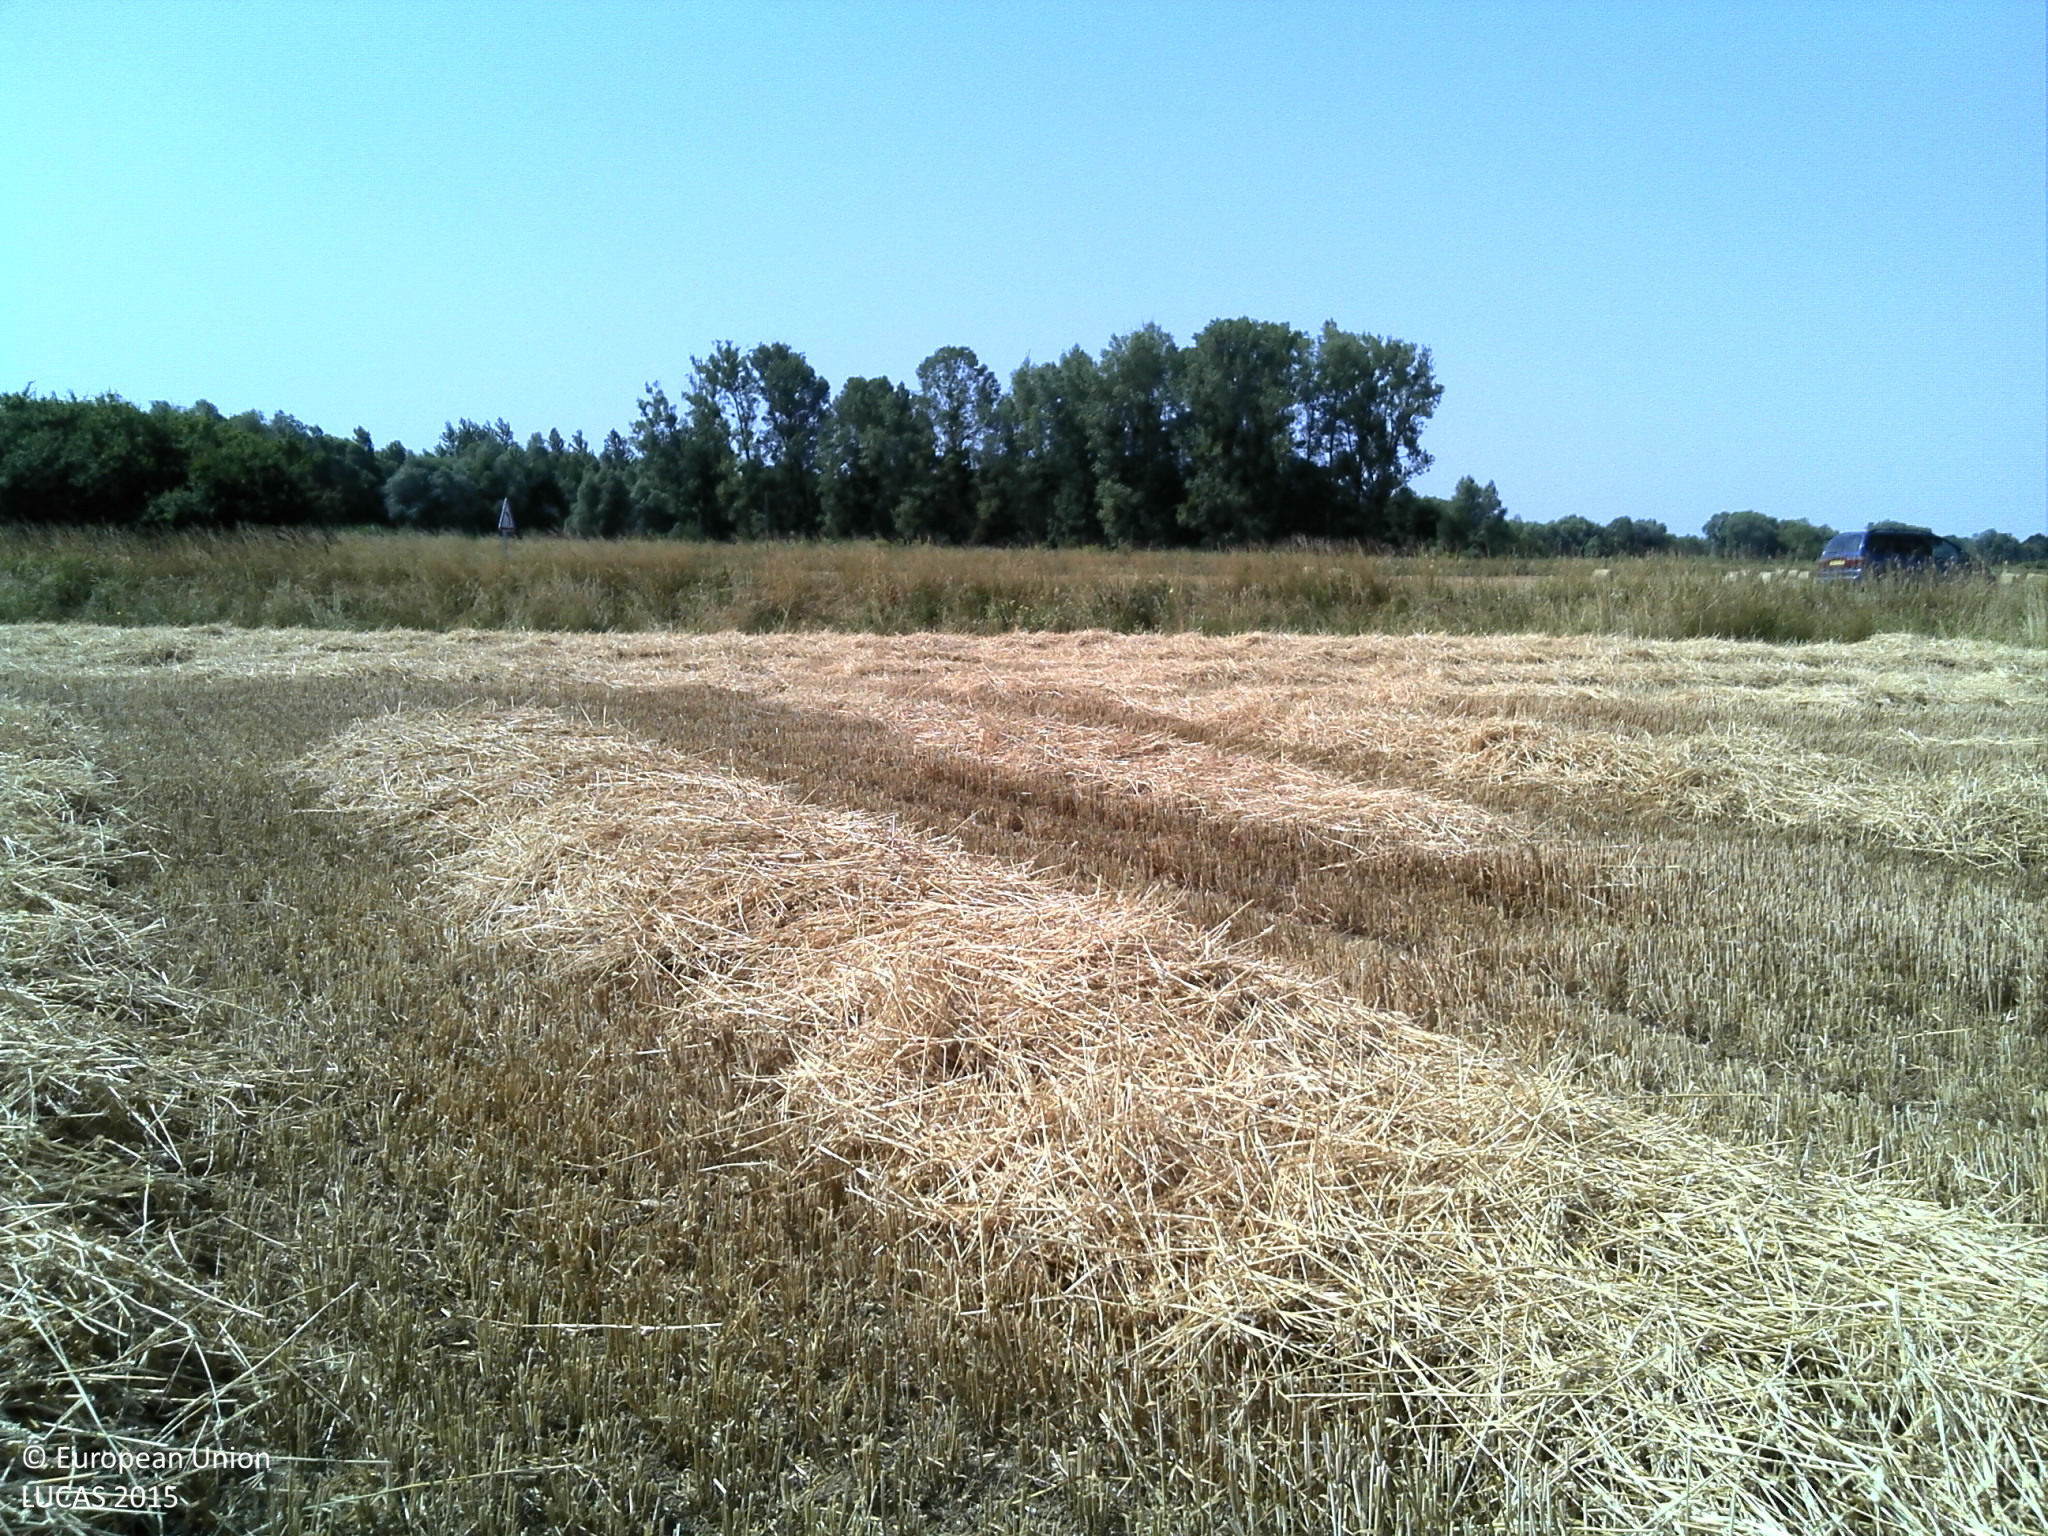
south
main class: Cropland
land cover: Common wheat
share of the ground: > 75 %
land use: Agriculture (excluding fallow land and kitchen gardens)
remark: Harvested field
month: July
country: FR
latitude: 48.7903
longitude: 4.8935
